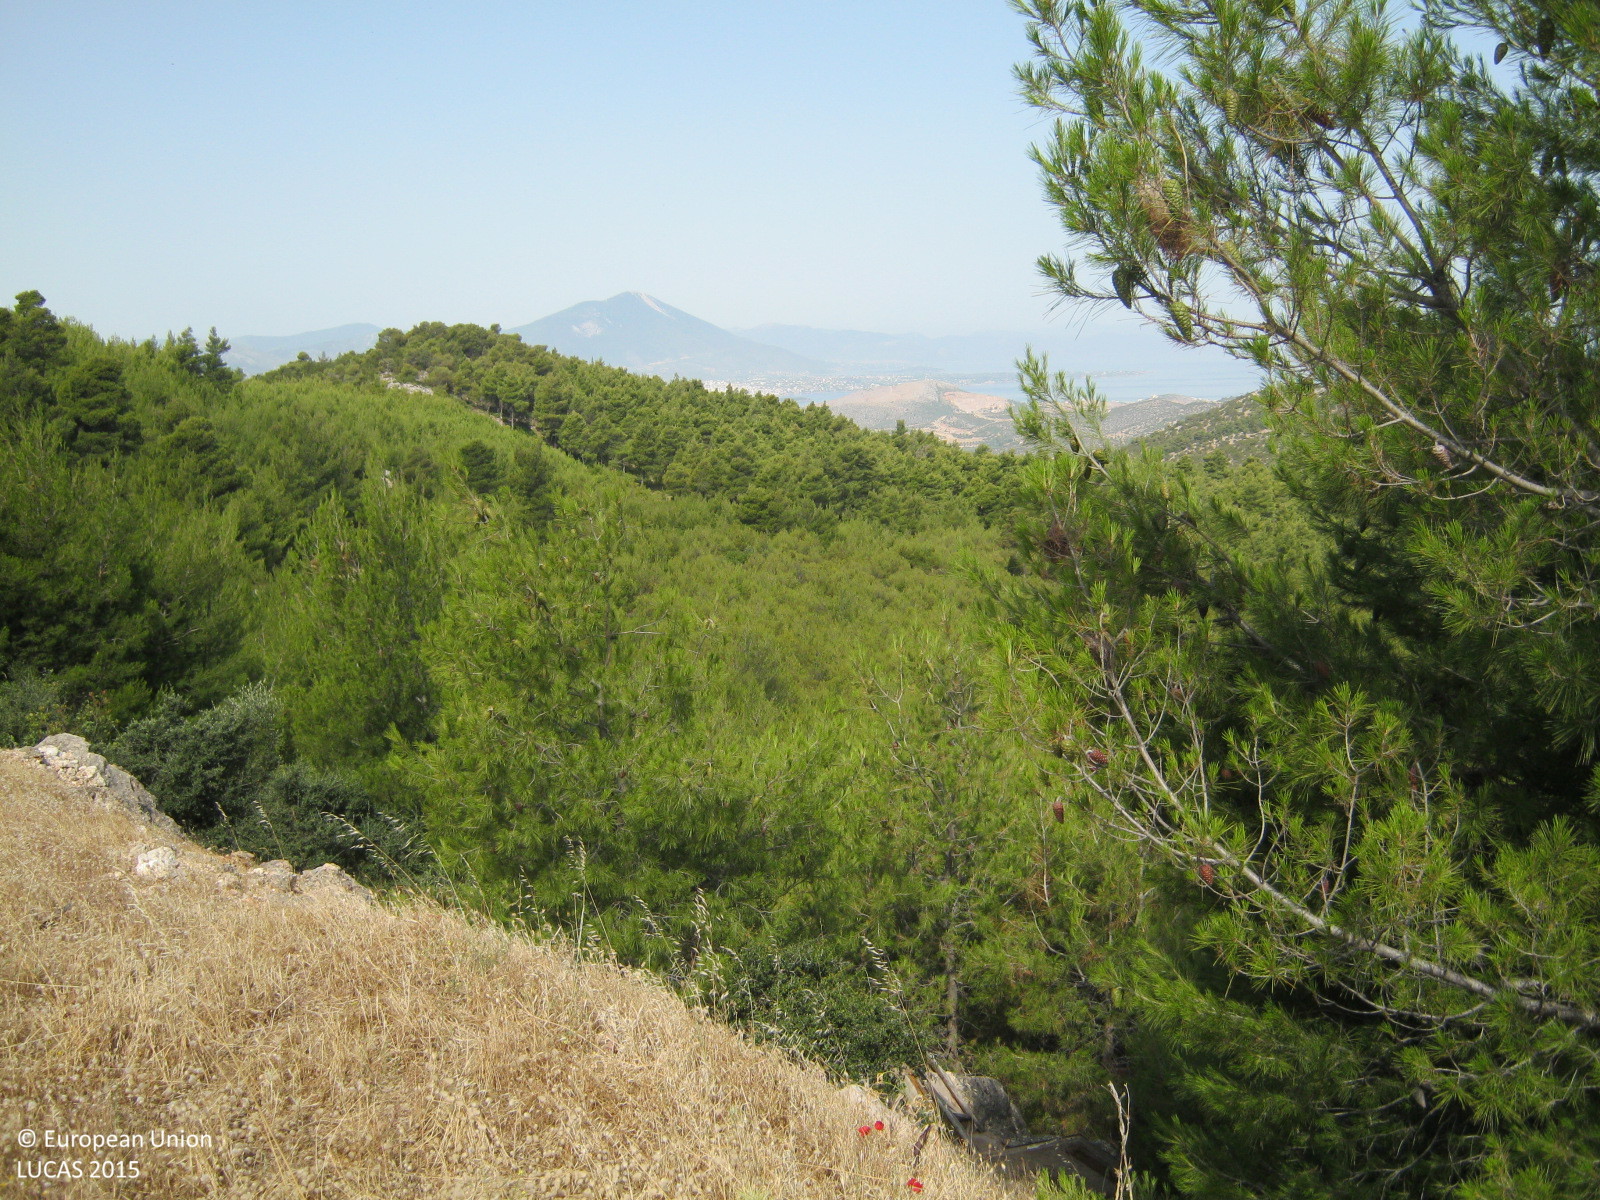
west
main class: Woodland
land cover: Pine dominated coniferous woodland
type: coniferous forest of the mediterranean region
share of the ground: > 75 %
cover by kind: coniferous forest trees 80 %, consolidated bare surface 15 %, shrubs 5 %
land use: Semi-natural and natural areas not in use
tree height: < 5 m
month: June
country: GR
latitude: 38.4719
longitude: 23.7305
